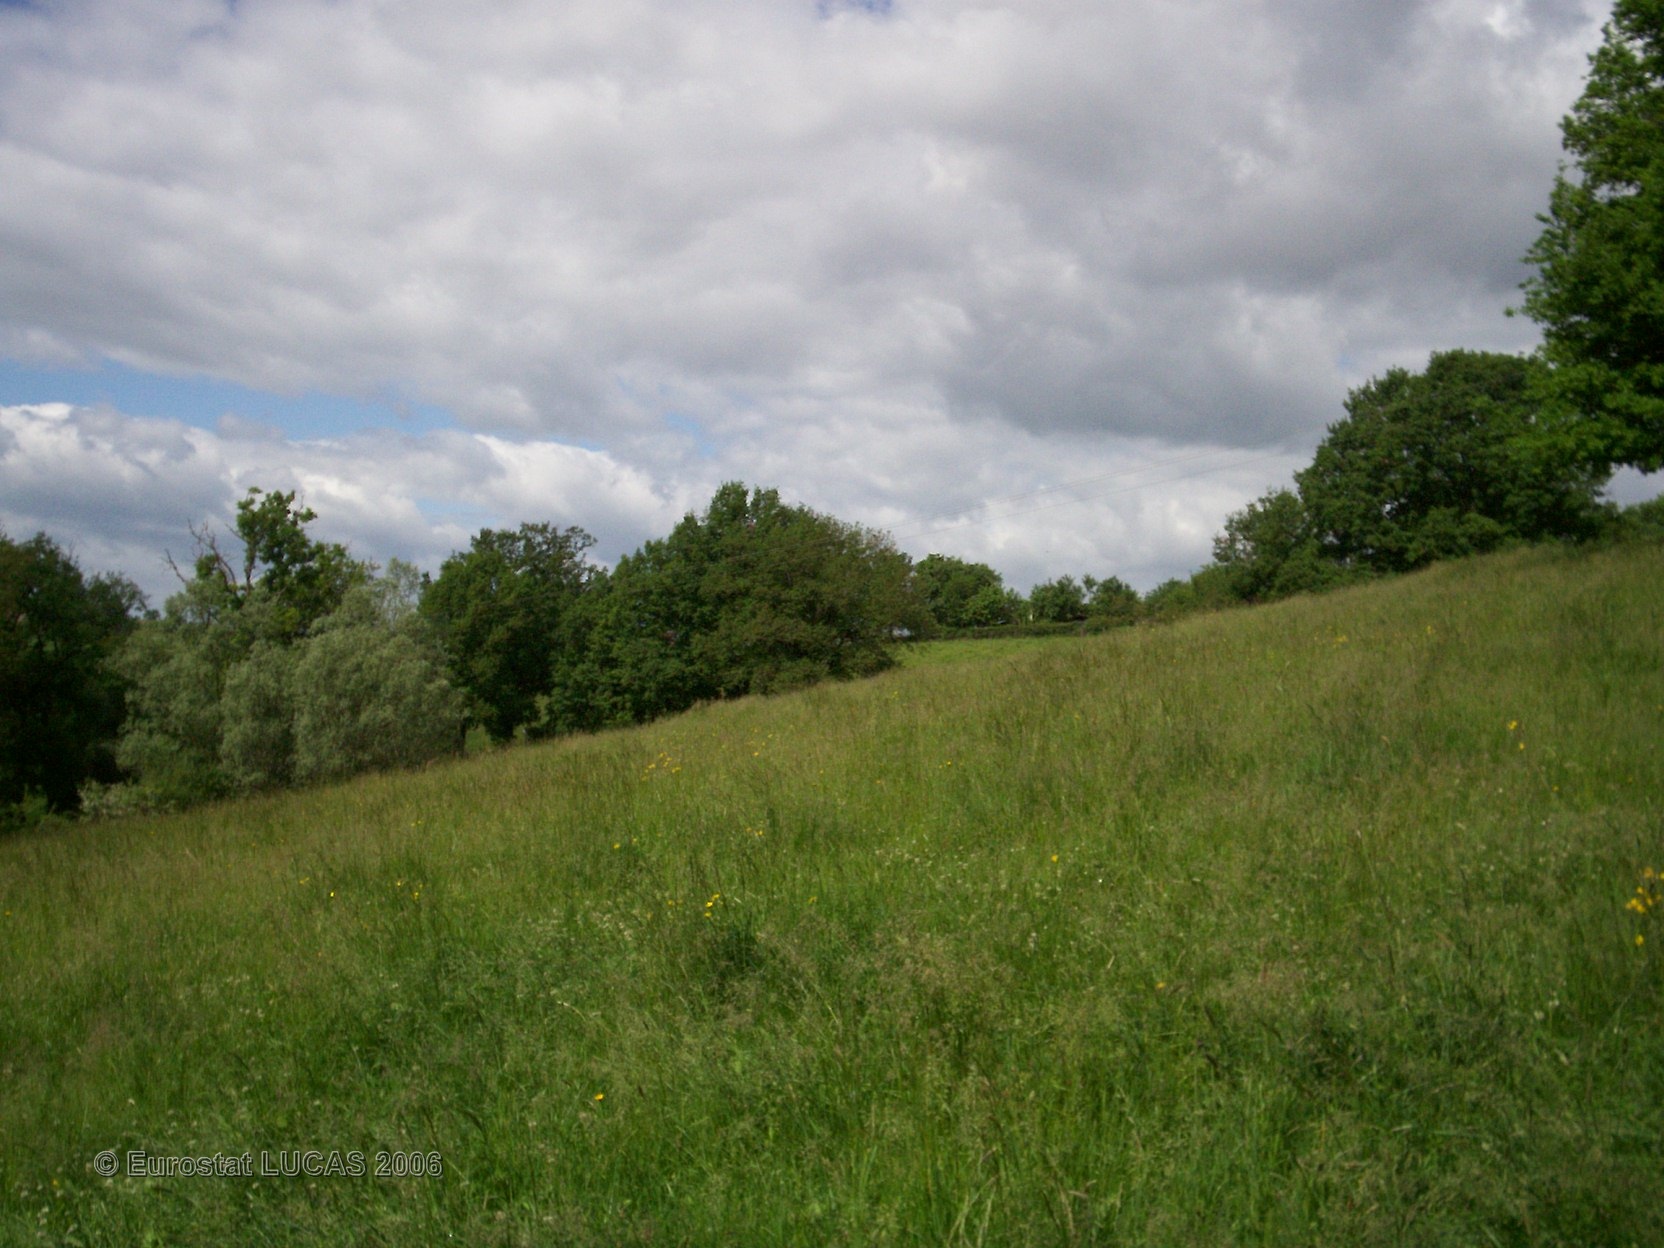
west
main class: Grassland
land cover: Grassland without tree/shrub cover
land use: Agriculture (excluding fallow land and kitchen gardens)
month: May
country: FR
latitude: 46.0645
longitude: 4.1456
